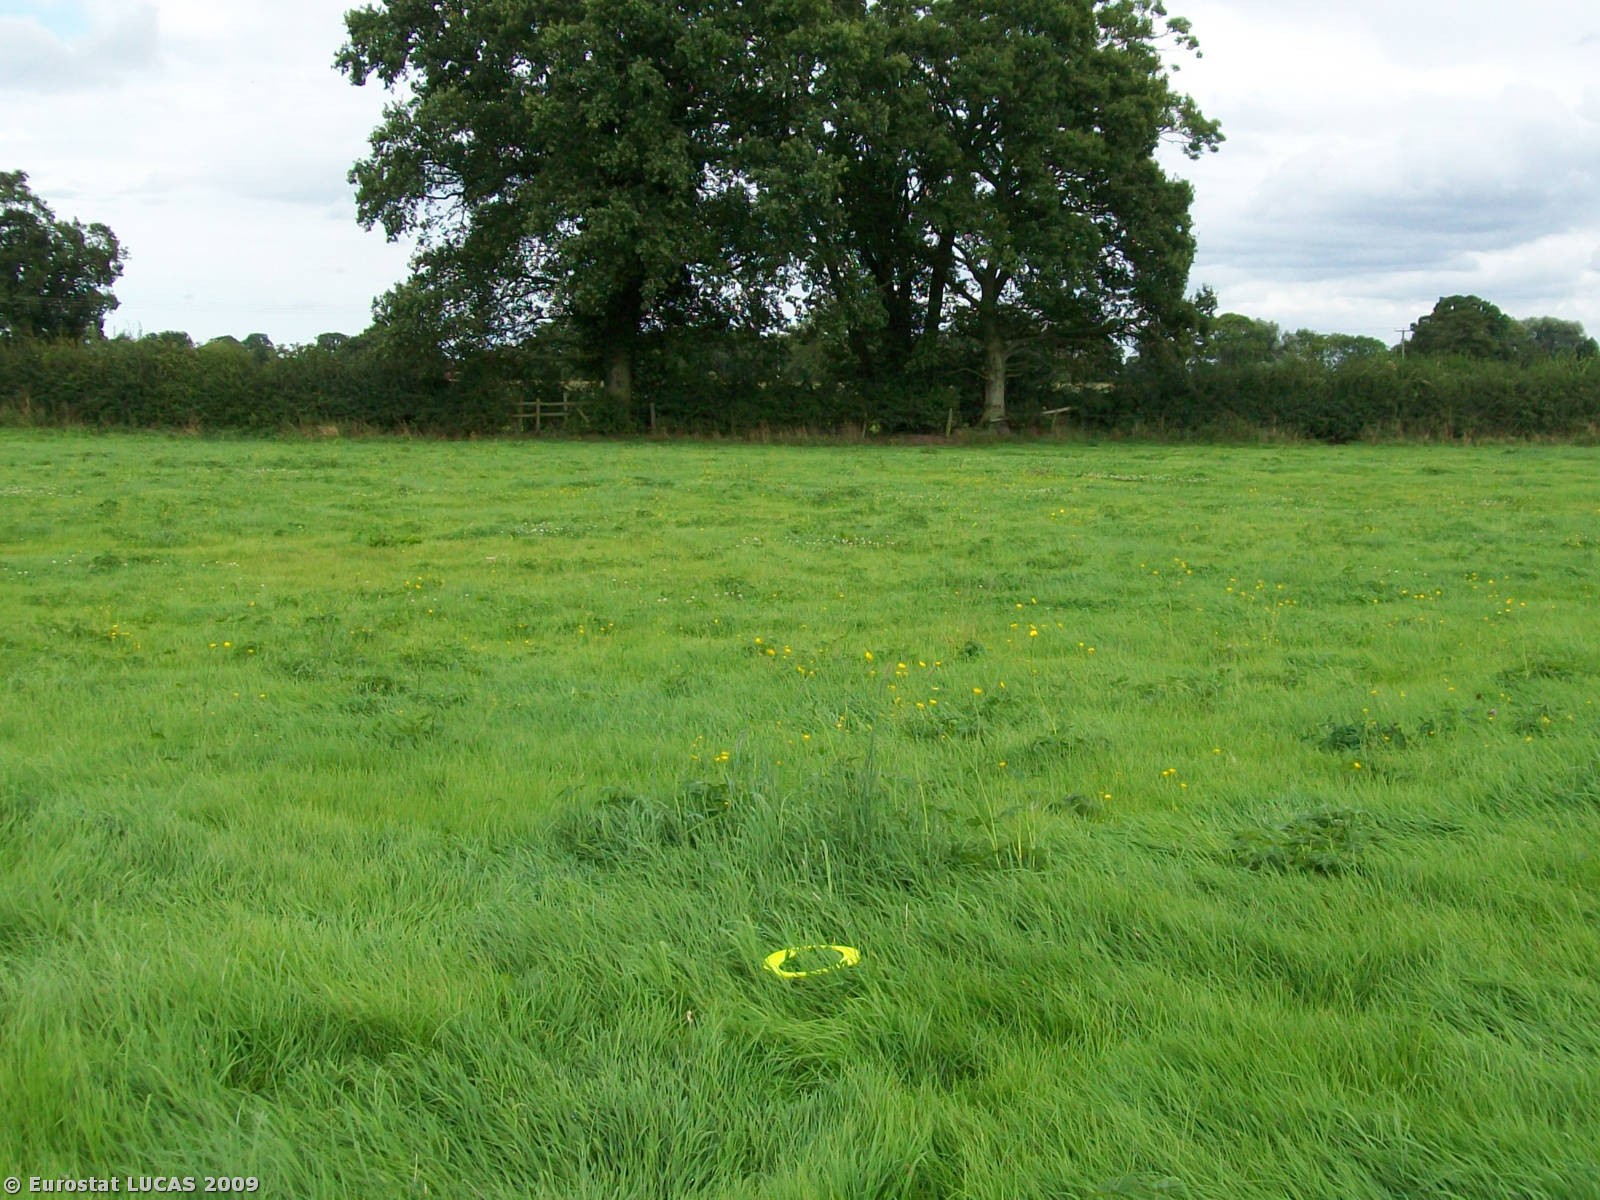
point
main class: Grassland
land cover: Grassland without tree/shrub cover
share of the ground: > 75 %
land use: Agriculture (excluding fallow land and kitchen gardens)
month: August
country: GB
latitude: 51.8879
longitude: -2.4004
